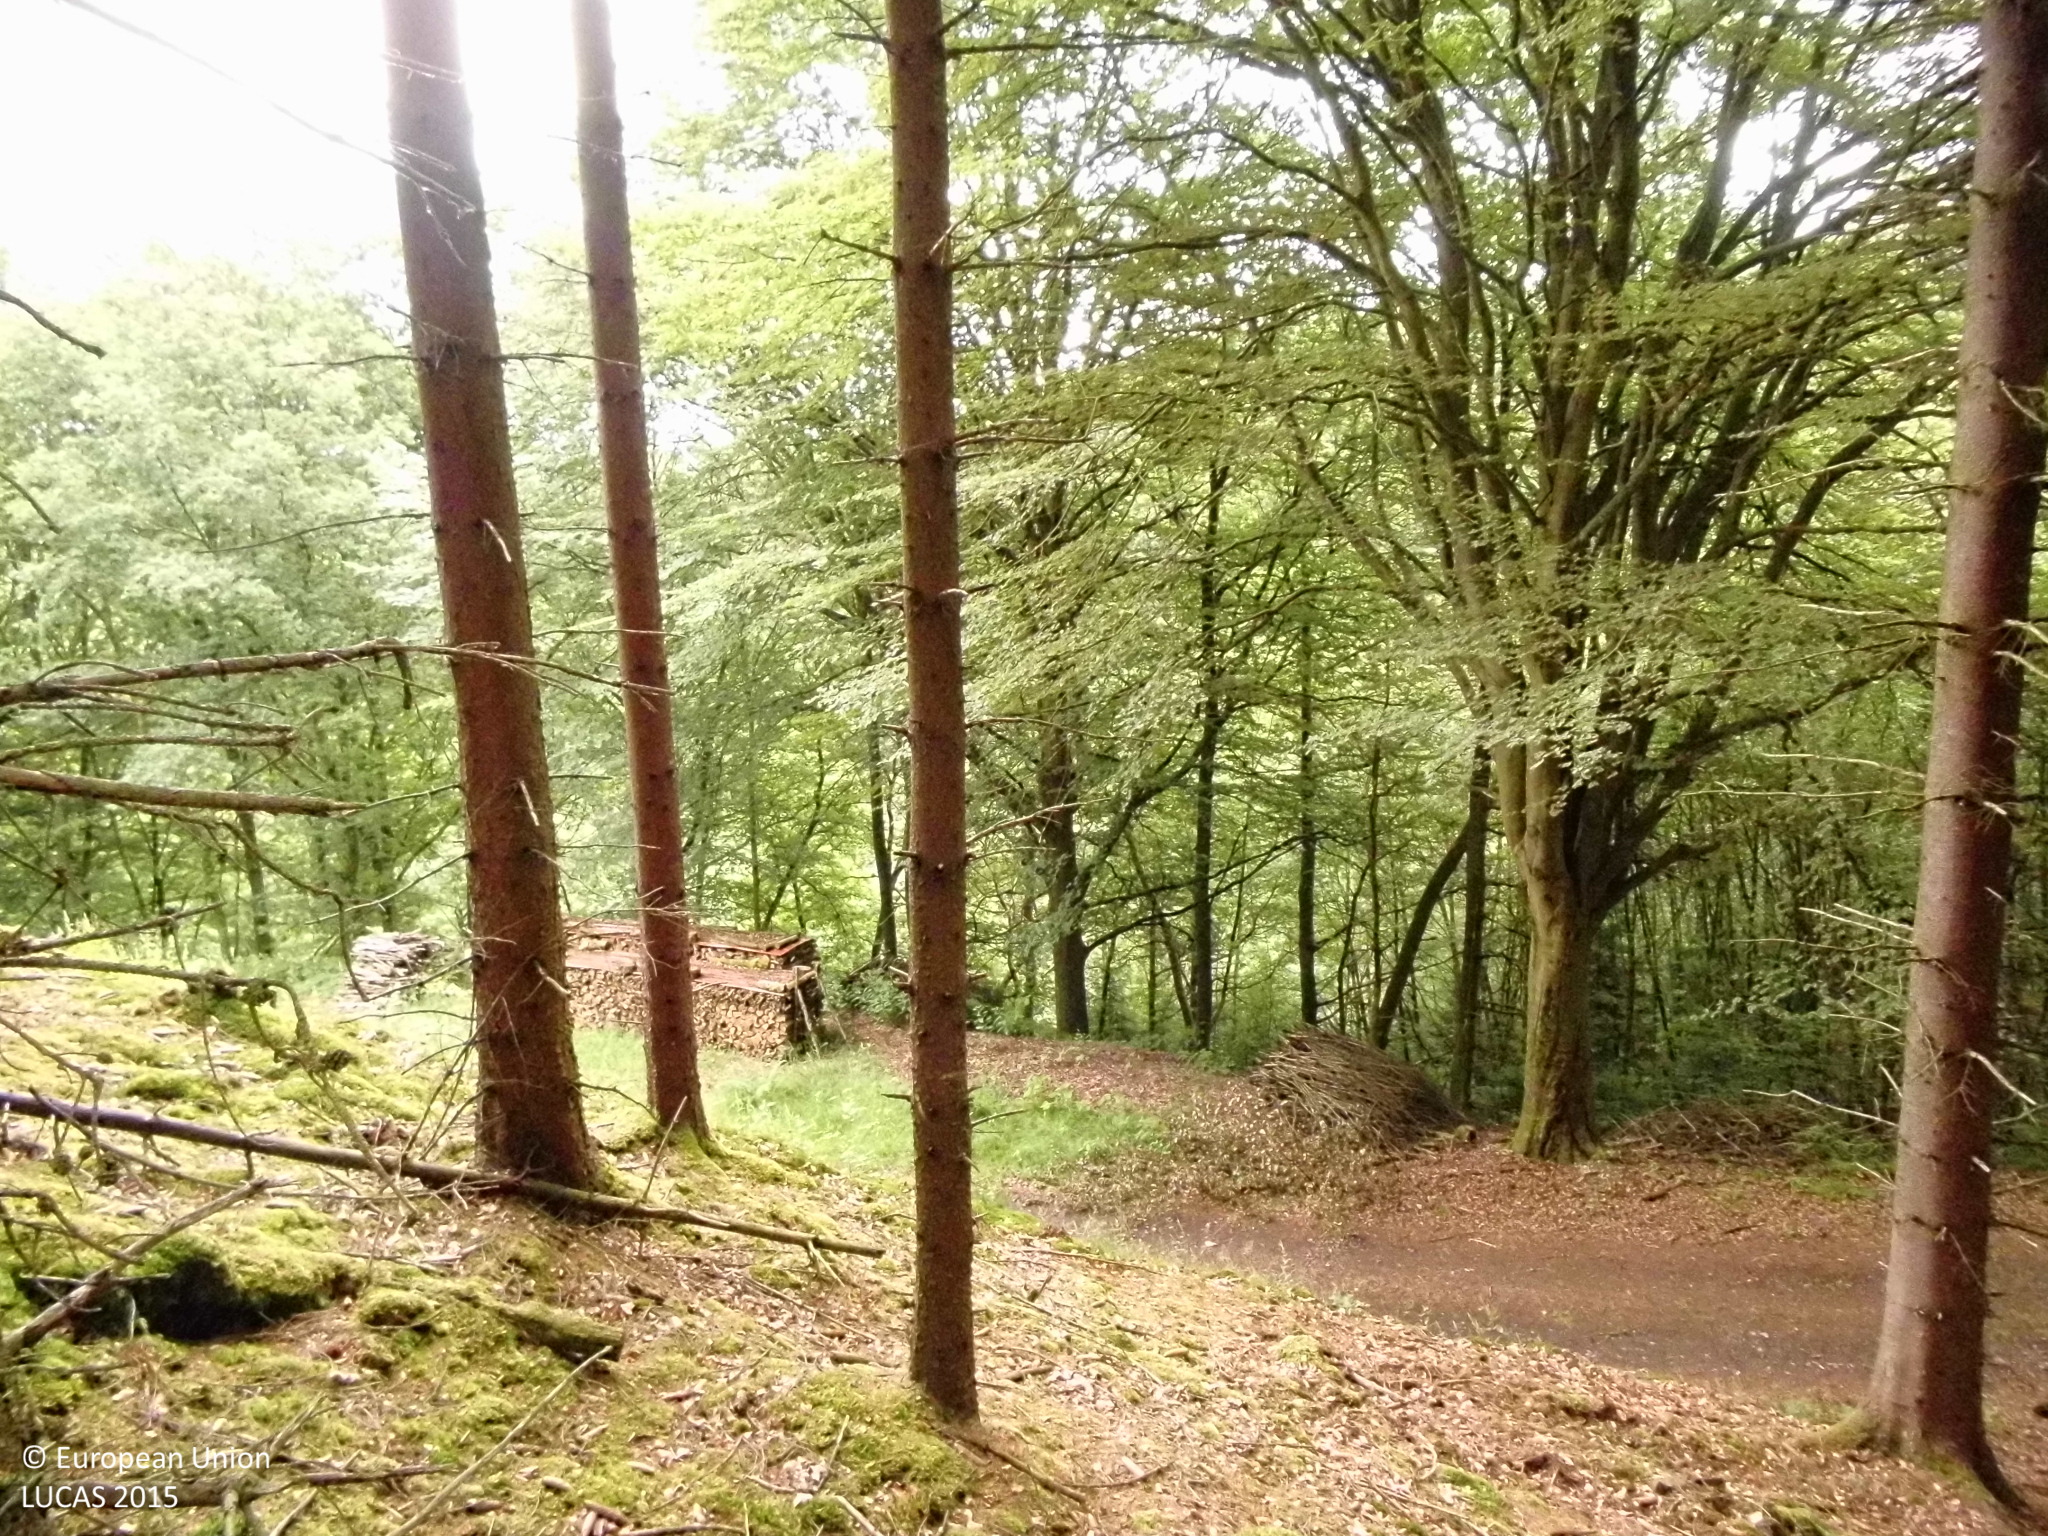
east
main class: Woodland
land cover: Spruce dominated coniferous woodland
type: hemiboreal forest and nemoral coniferous forest and mixed broadleaved-coniferous forest
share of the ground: > 75 %
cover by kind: coniferous forest trees 85 %, lichens and mosses 10 %, unconsolidated bare surface 5 %
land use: Forestry
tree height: > 5 m
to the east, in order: Spruce dominated coniferous woodland; Shruby margins; Tracks; Broadleaved woodland; Grassland without tree/shrub cover; Rivers and streams; Groves; Spruce dominated coniferous woodland; Tracks; Spruce dominated coniferous woodland
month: July
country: DE
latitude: 50.7603
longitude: 8.0015
